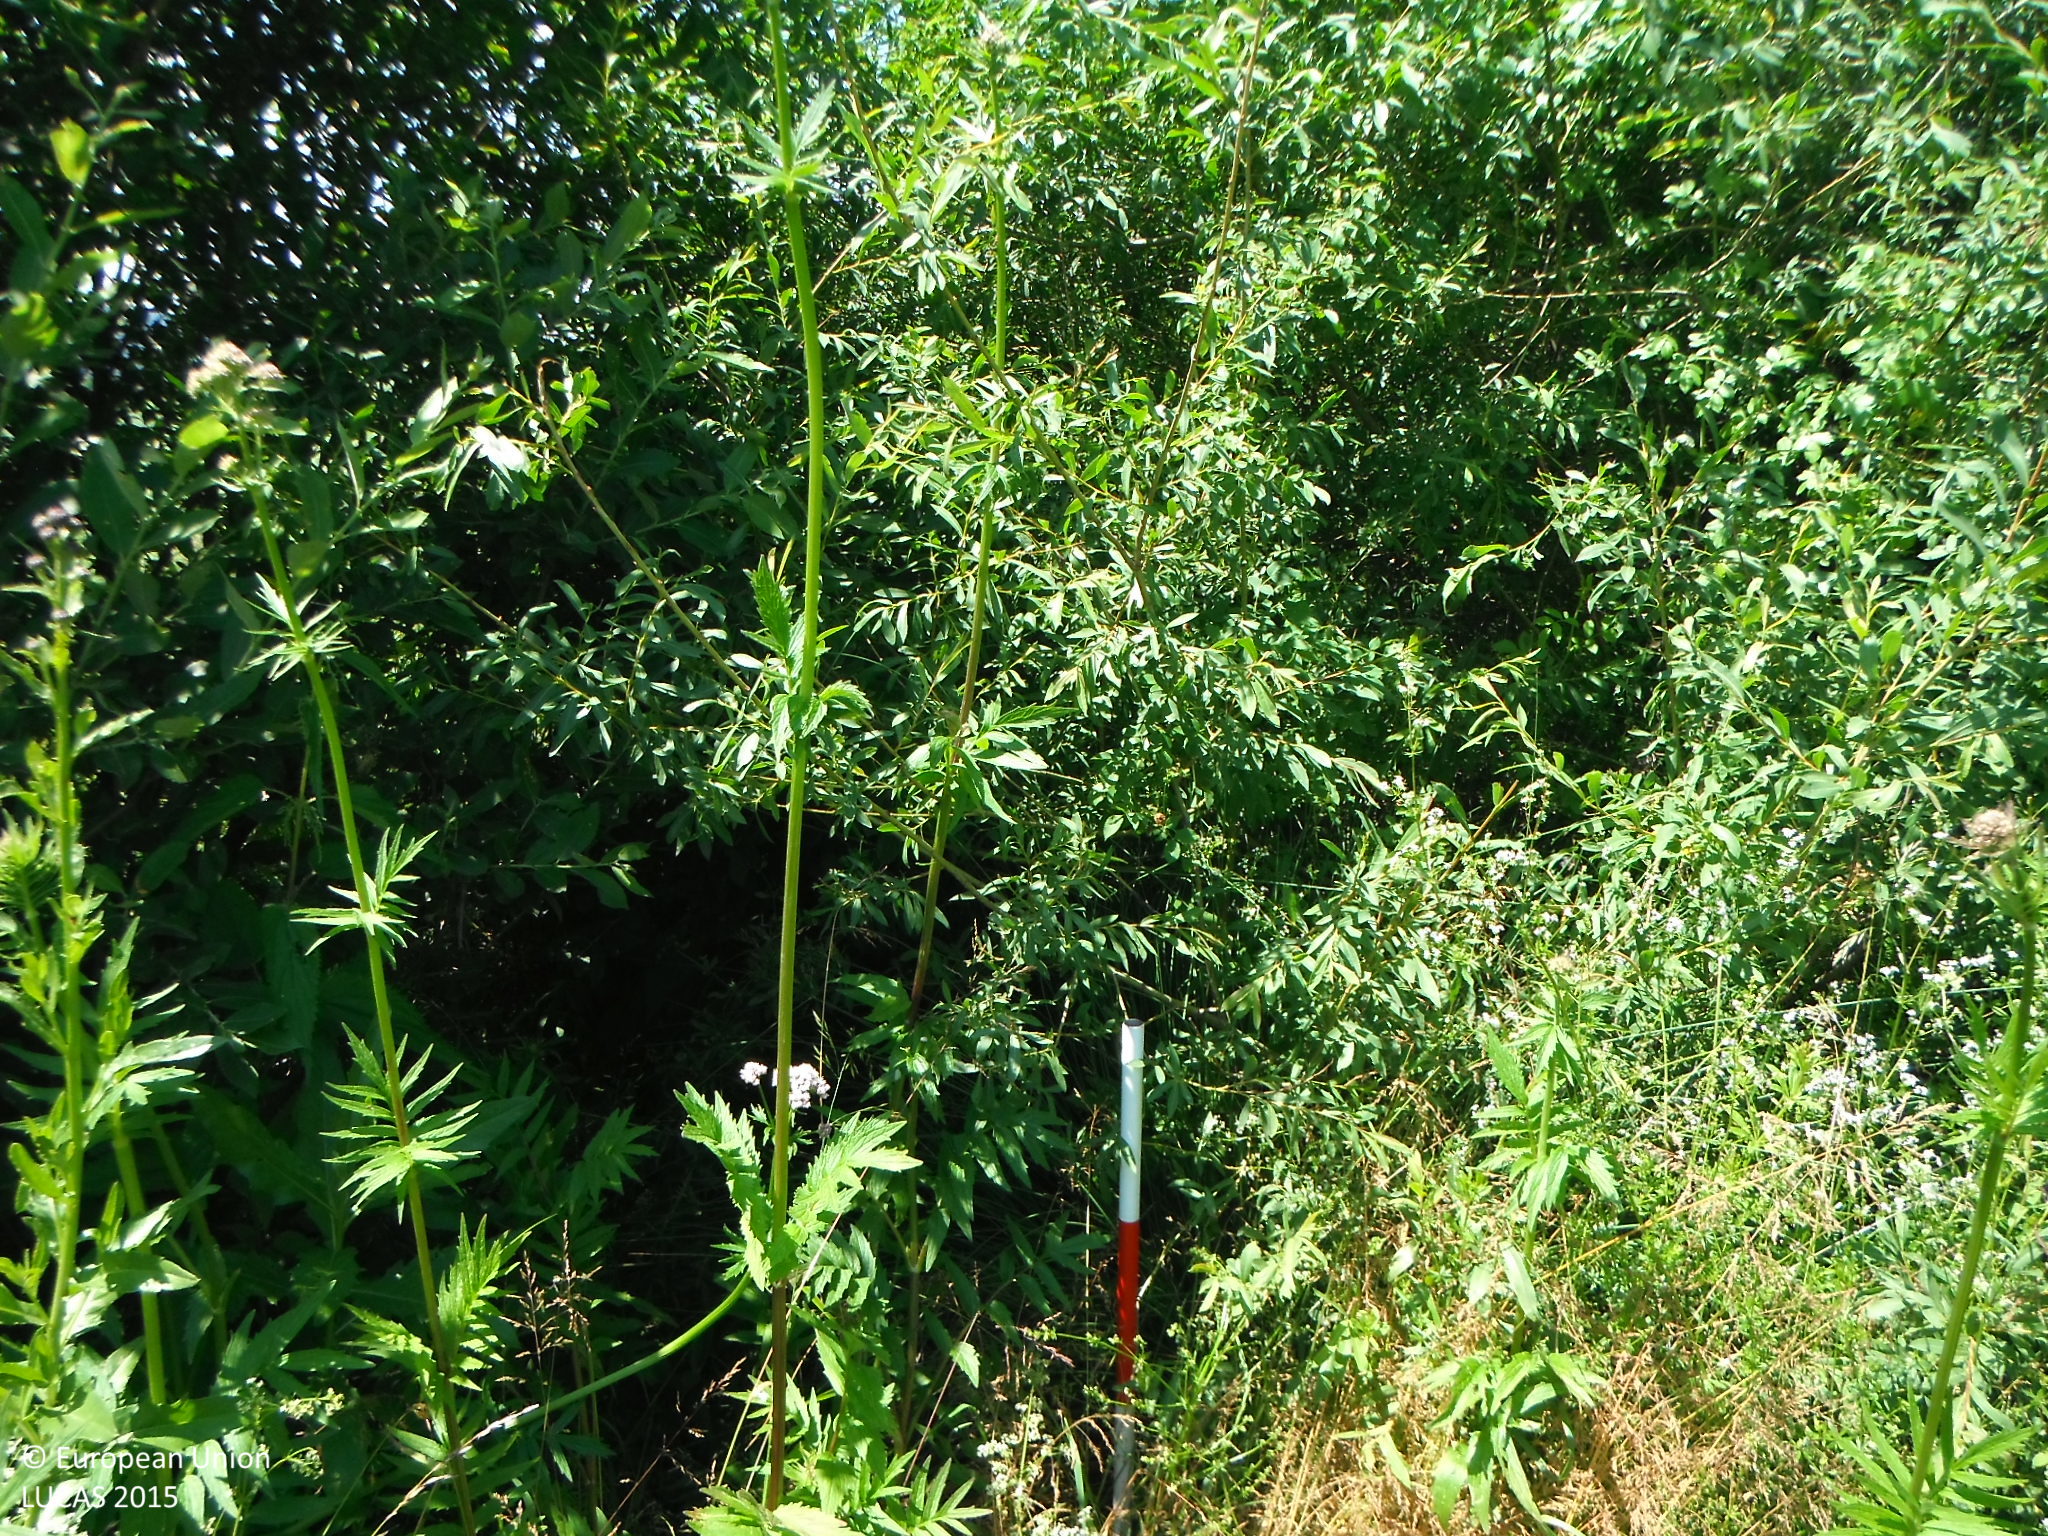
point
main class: Shrubland
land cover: Shrubland without tree cover
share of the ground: > 75 %
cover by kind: shrubs 100 %
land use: Semi-natural and natural areas not in use
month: July
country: SK
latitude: 49.0014
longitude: 20.1889
